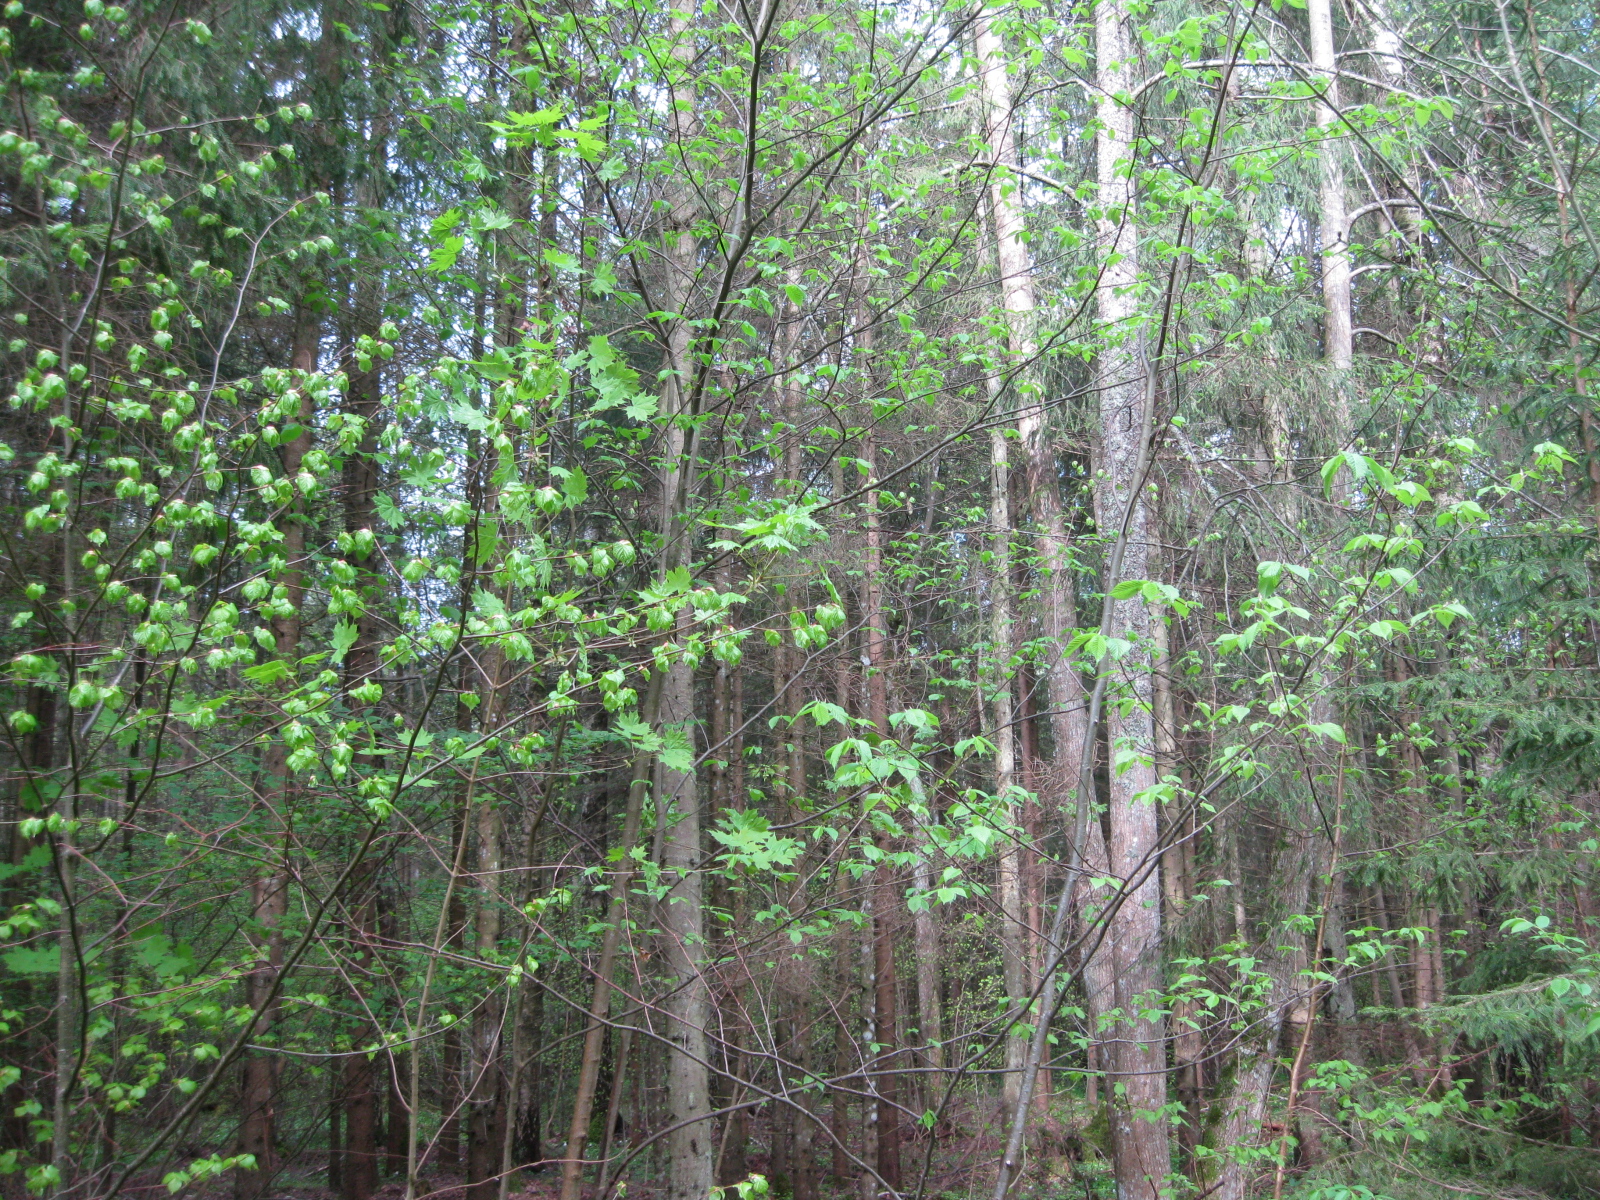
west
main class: Woodland
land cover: Broadleaved woodland
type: non-riverine alder, birch or aspen forest
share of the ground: > 75 %
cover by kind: broadleaved forest trees 65 %, herbaceous plants 25 %, coniferous forest trees 10 %
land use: Forestry
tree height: > 5 m
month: May
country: LT
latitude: 56.2549
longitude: 24.9742
